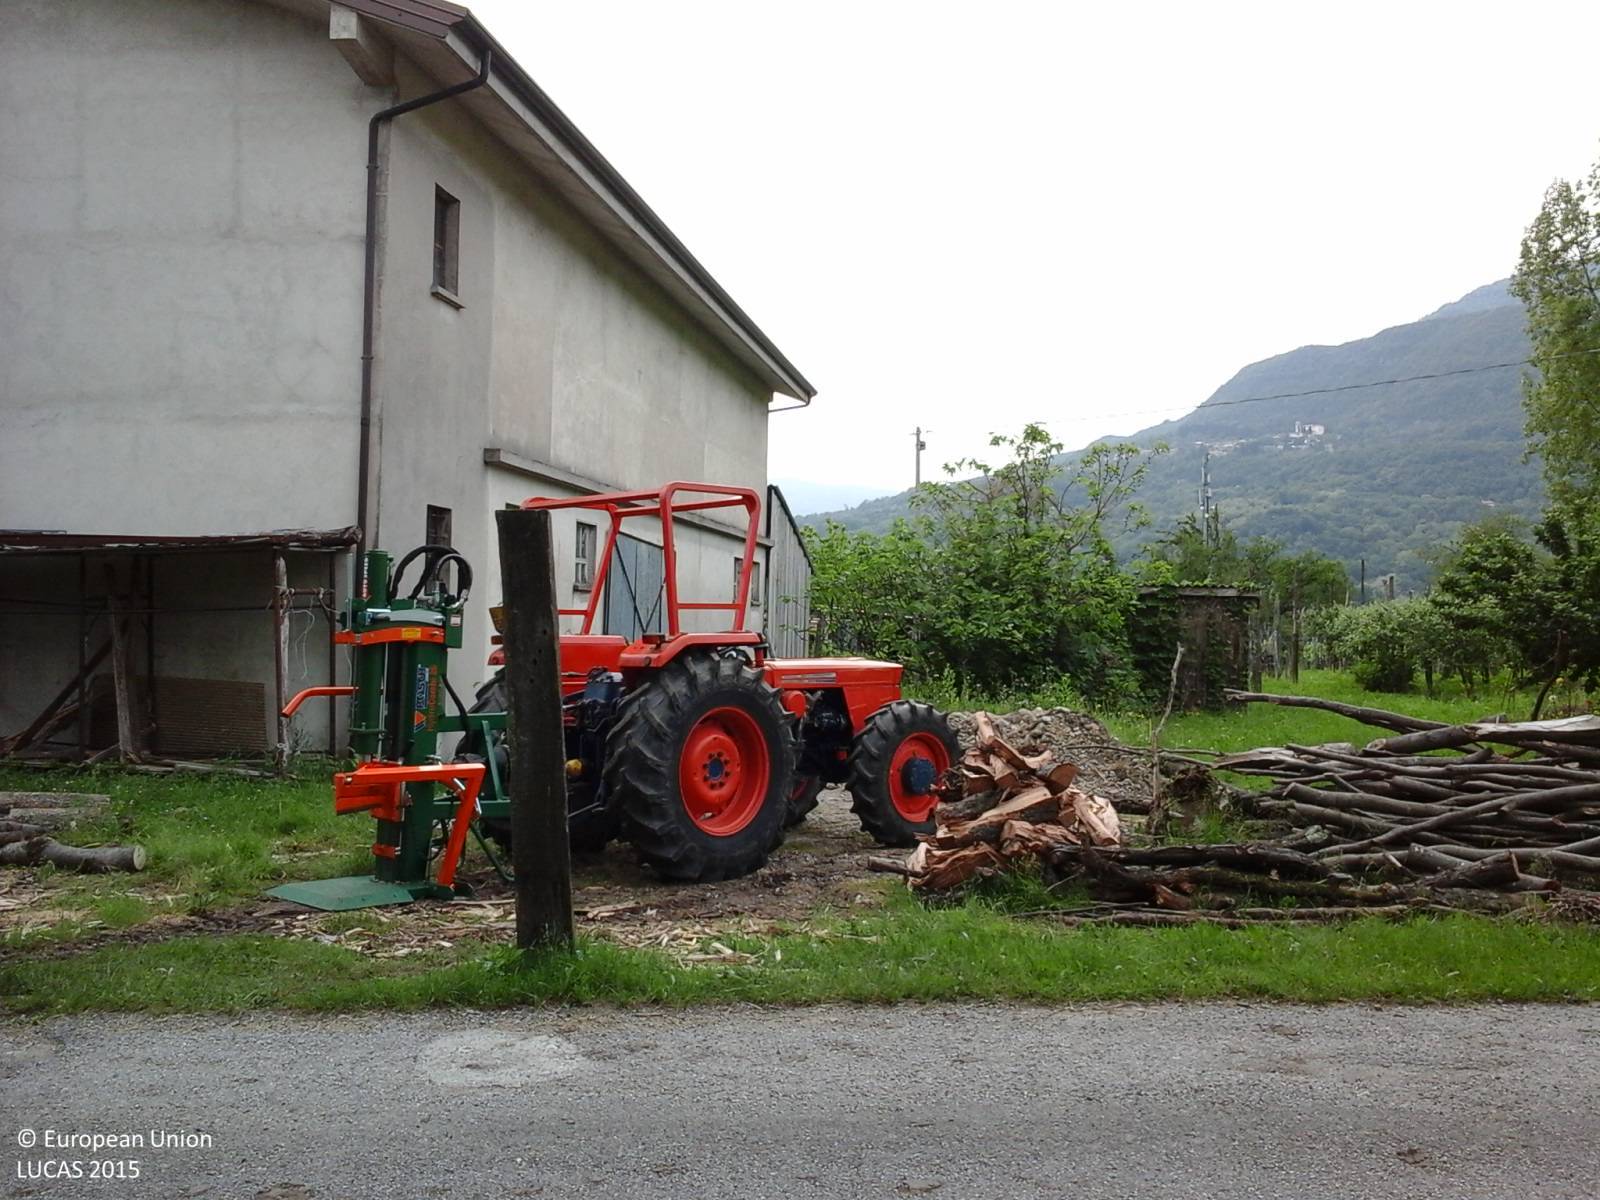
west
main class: Woodland
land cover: Broadleaved woodland
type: mesophytic deciduous forest
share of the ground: > 75 %
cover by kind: broadleaved forest trees 60 %, shrubs 25 %, herbaceous plants 15 %
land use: Forestry
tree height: > 5 m
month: May
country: IT
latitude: 46.2200
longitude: 12.9655
